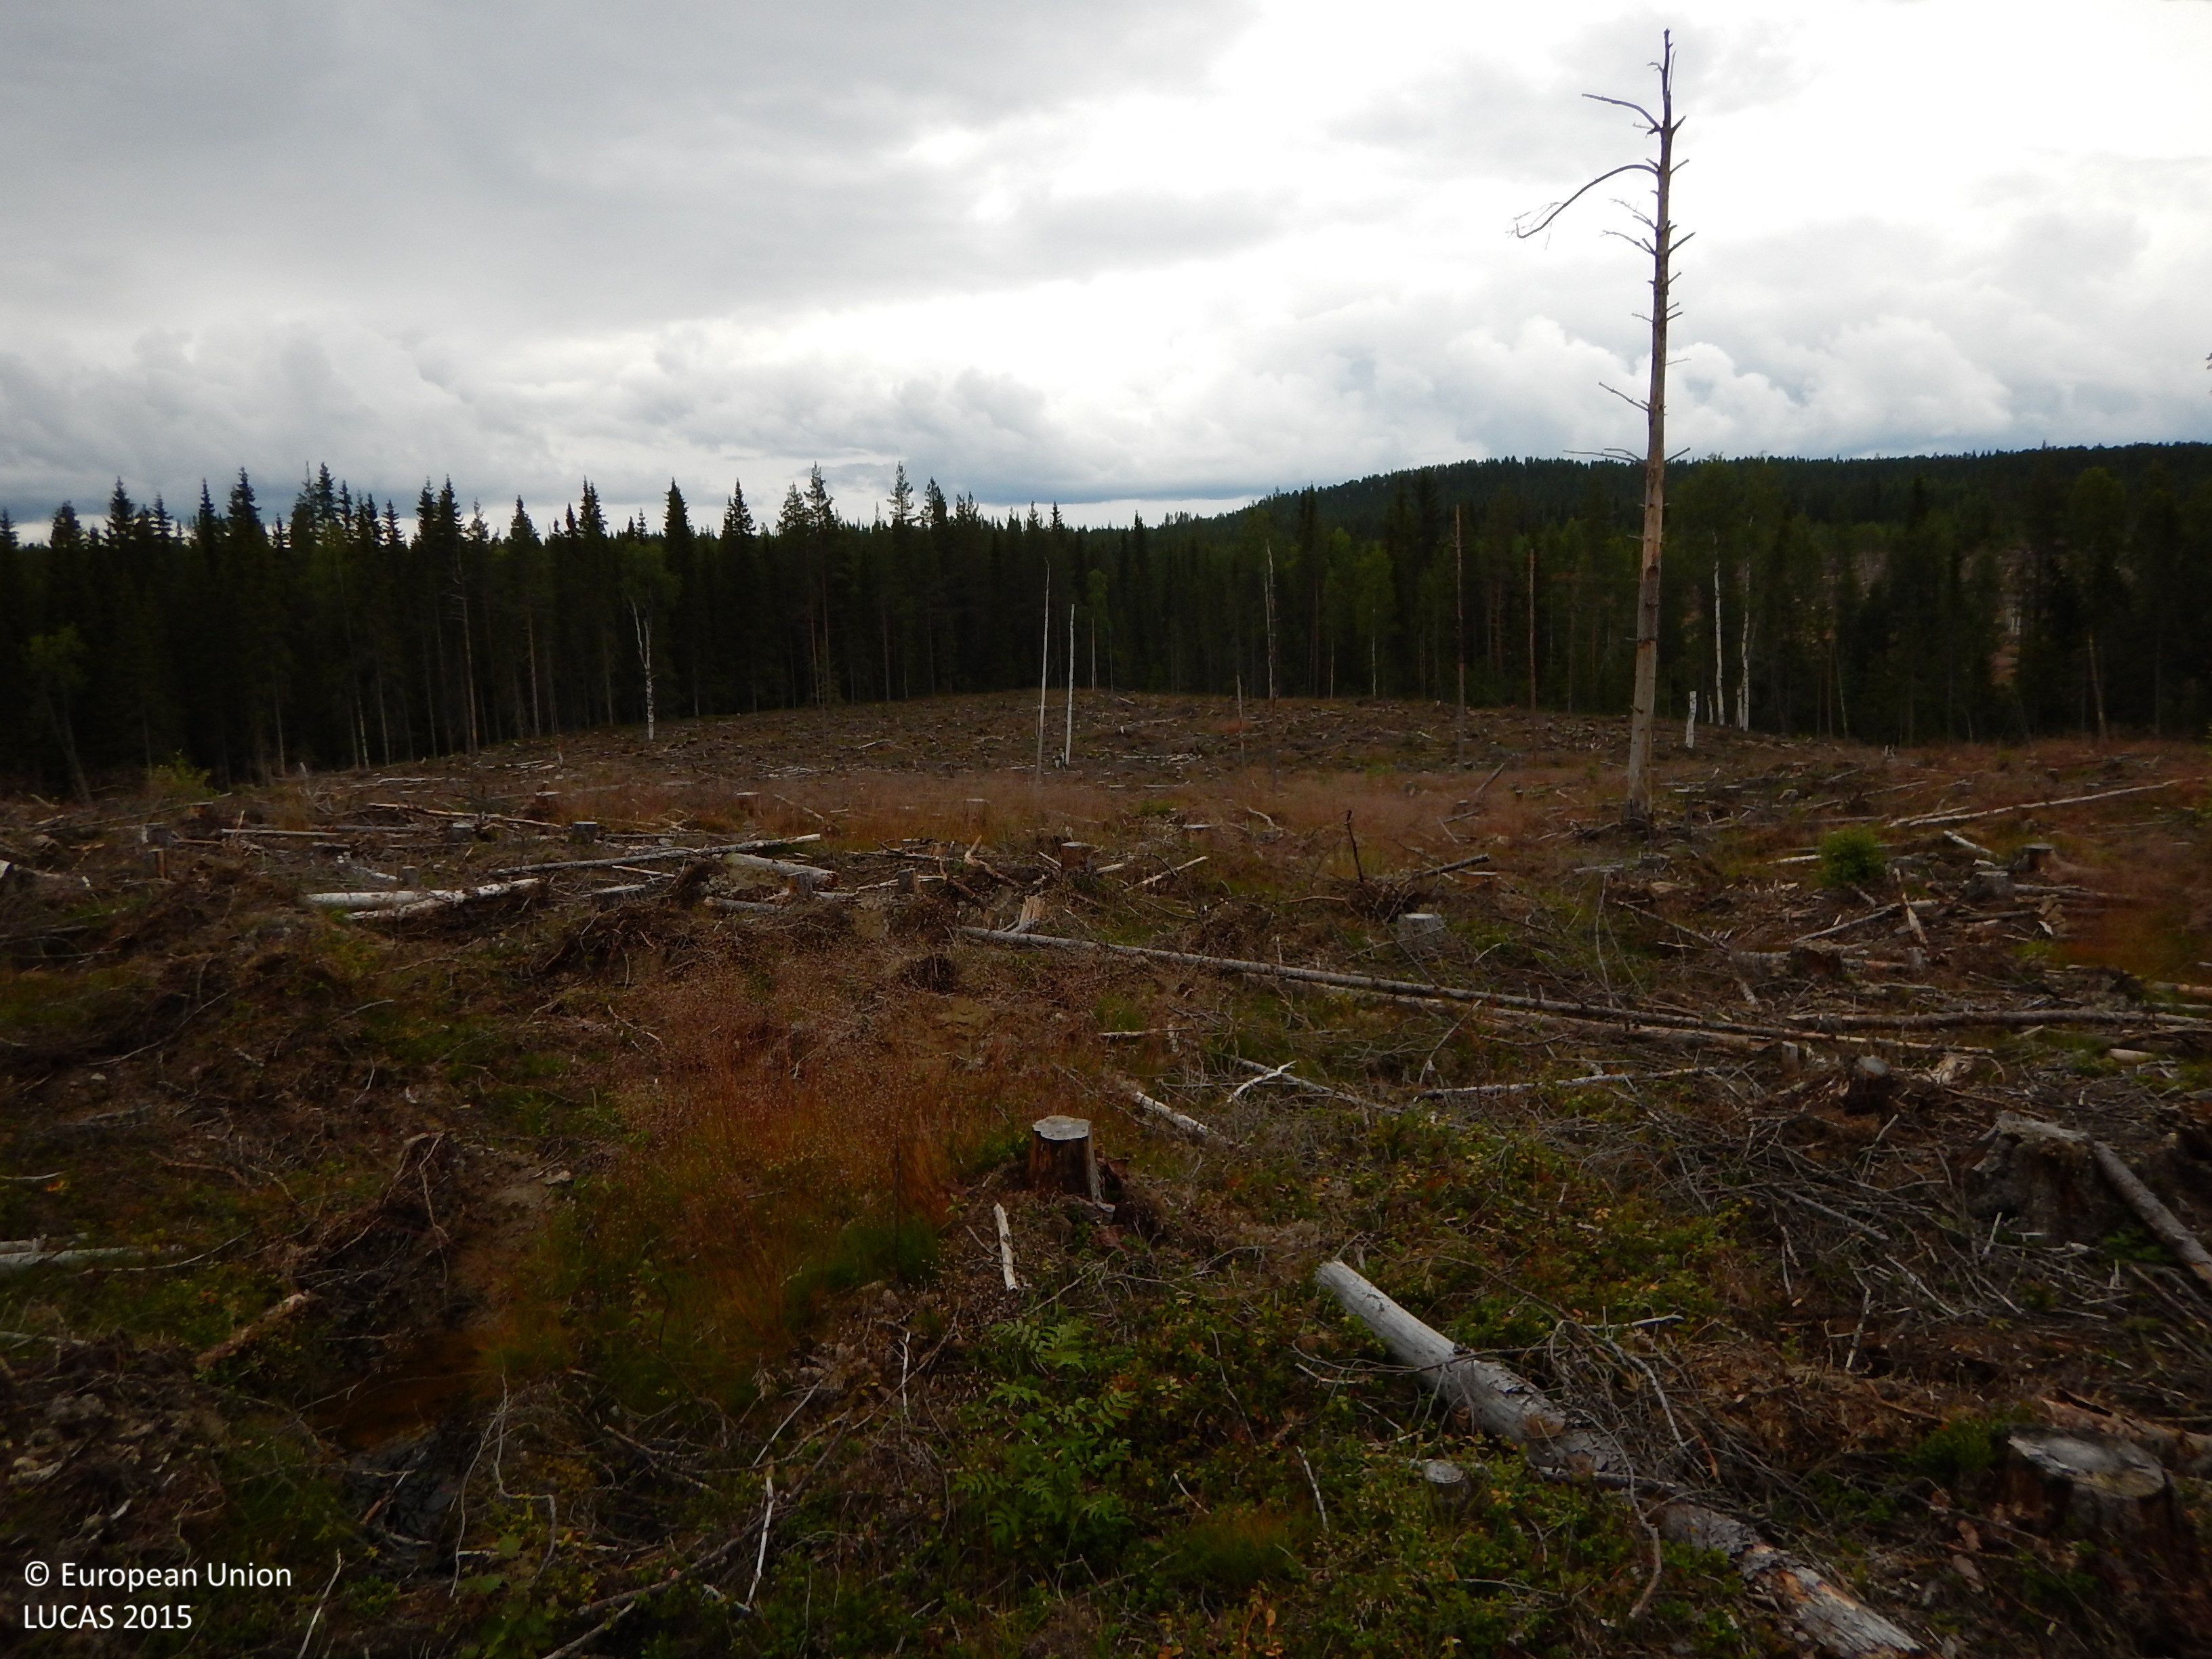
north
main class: Grassland
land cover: Grassland without tree/shrub cover
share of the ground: 25 - 50 %
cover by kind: unconsolidated bare surface 35 %, herbaceous plants 30 %, lichens and mosses 20 %, consolidated bare surface 10 %, shrubs 5 %
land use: Forestry
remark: Clear cut
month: July
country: SE
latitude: 64.9470
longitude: 20.4490
